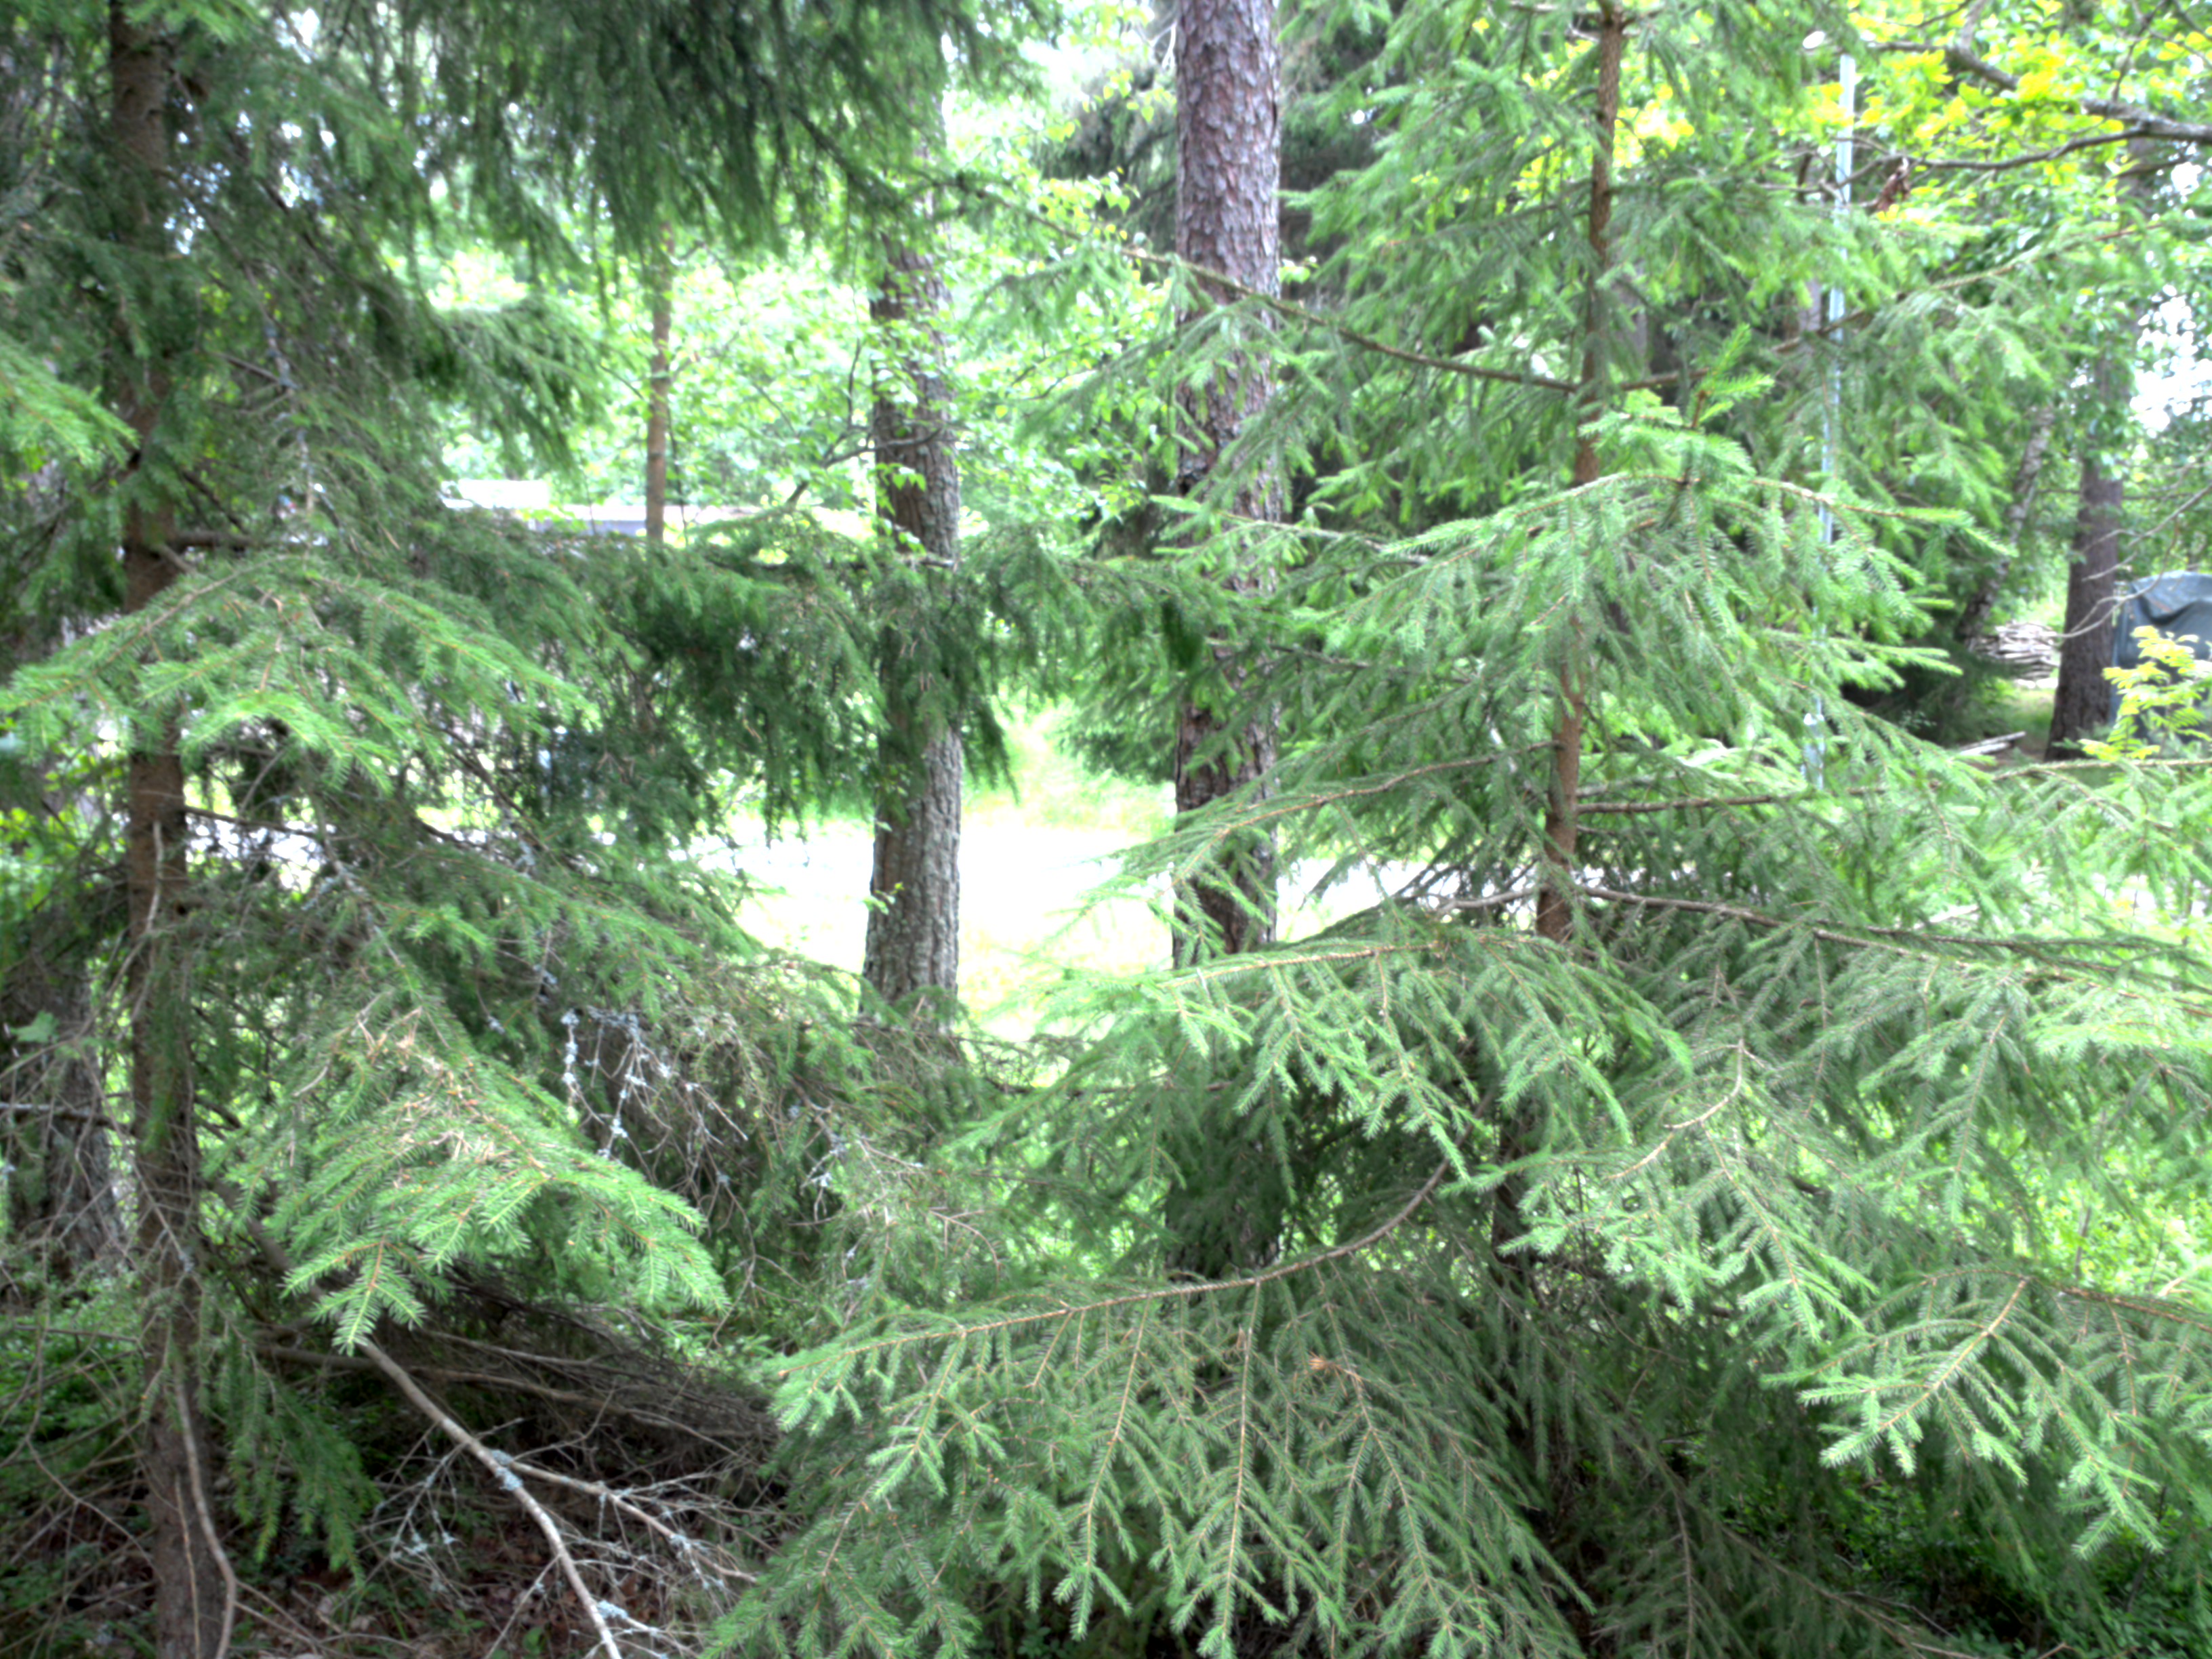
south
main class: Woodland
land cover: Pine dominated coniferous woodland
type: boreal forest
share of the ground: 50 - 75 %
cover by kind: coniferous forest trees 70 %, shrubs 25 %, herbaceous plants 5 %
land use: Forestry
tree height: > 5 m
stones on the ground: < 10 %
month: June
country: SE
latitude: 59.2563
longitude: 17.5204
